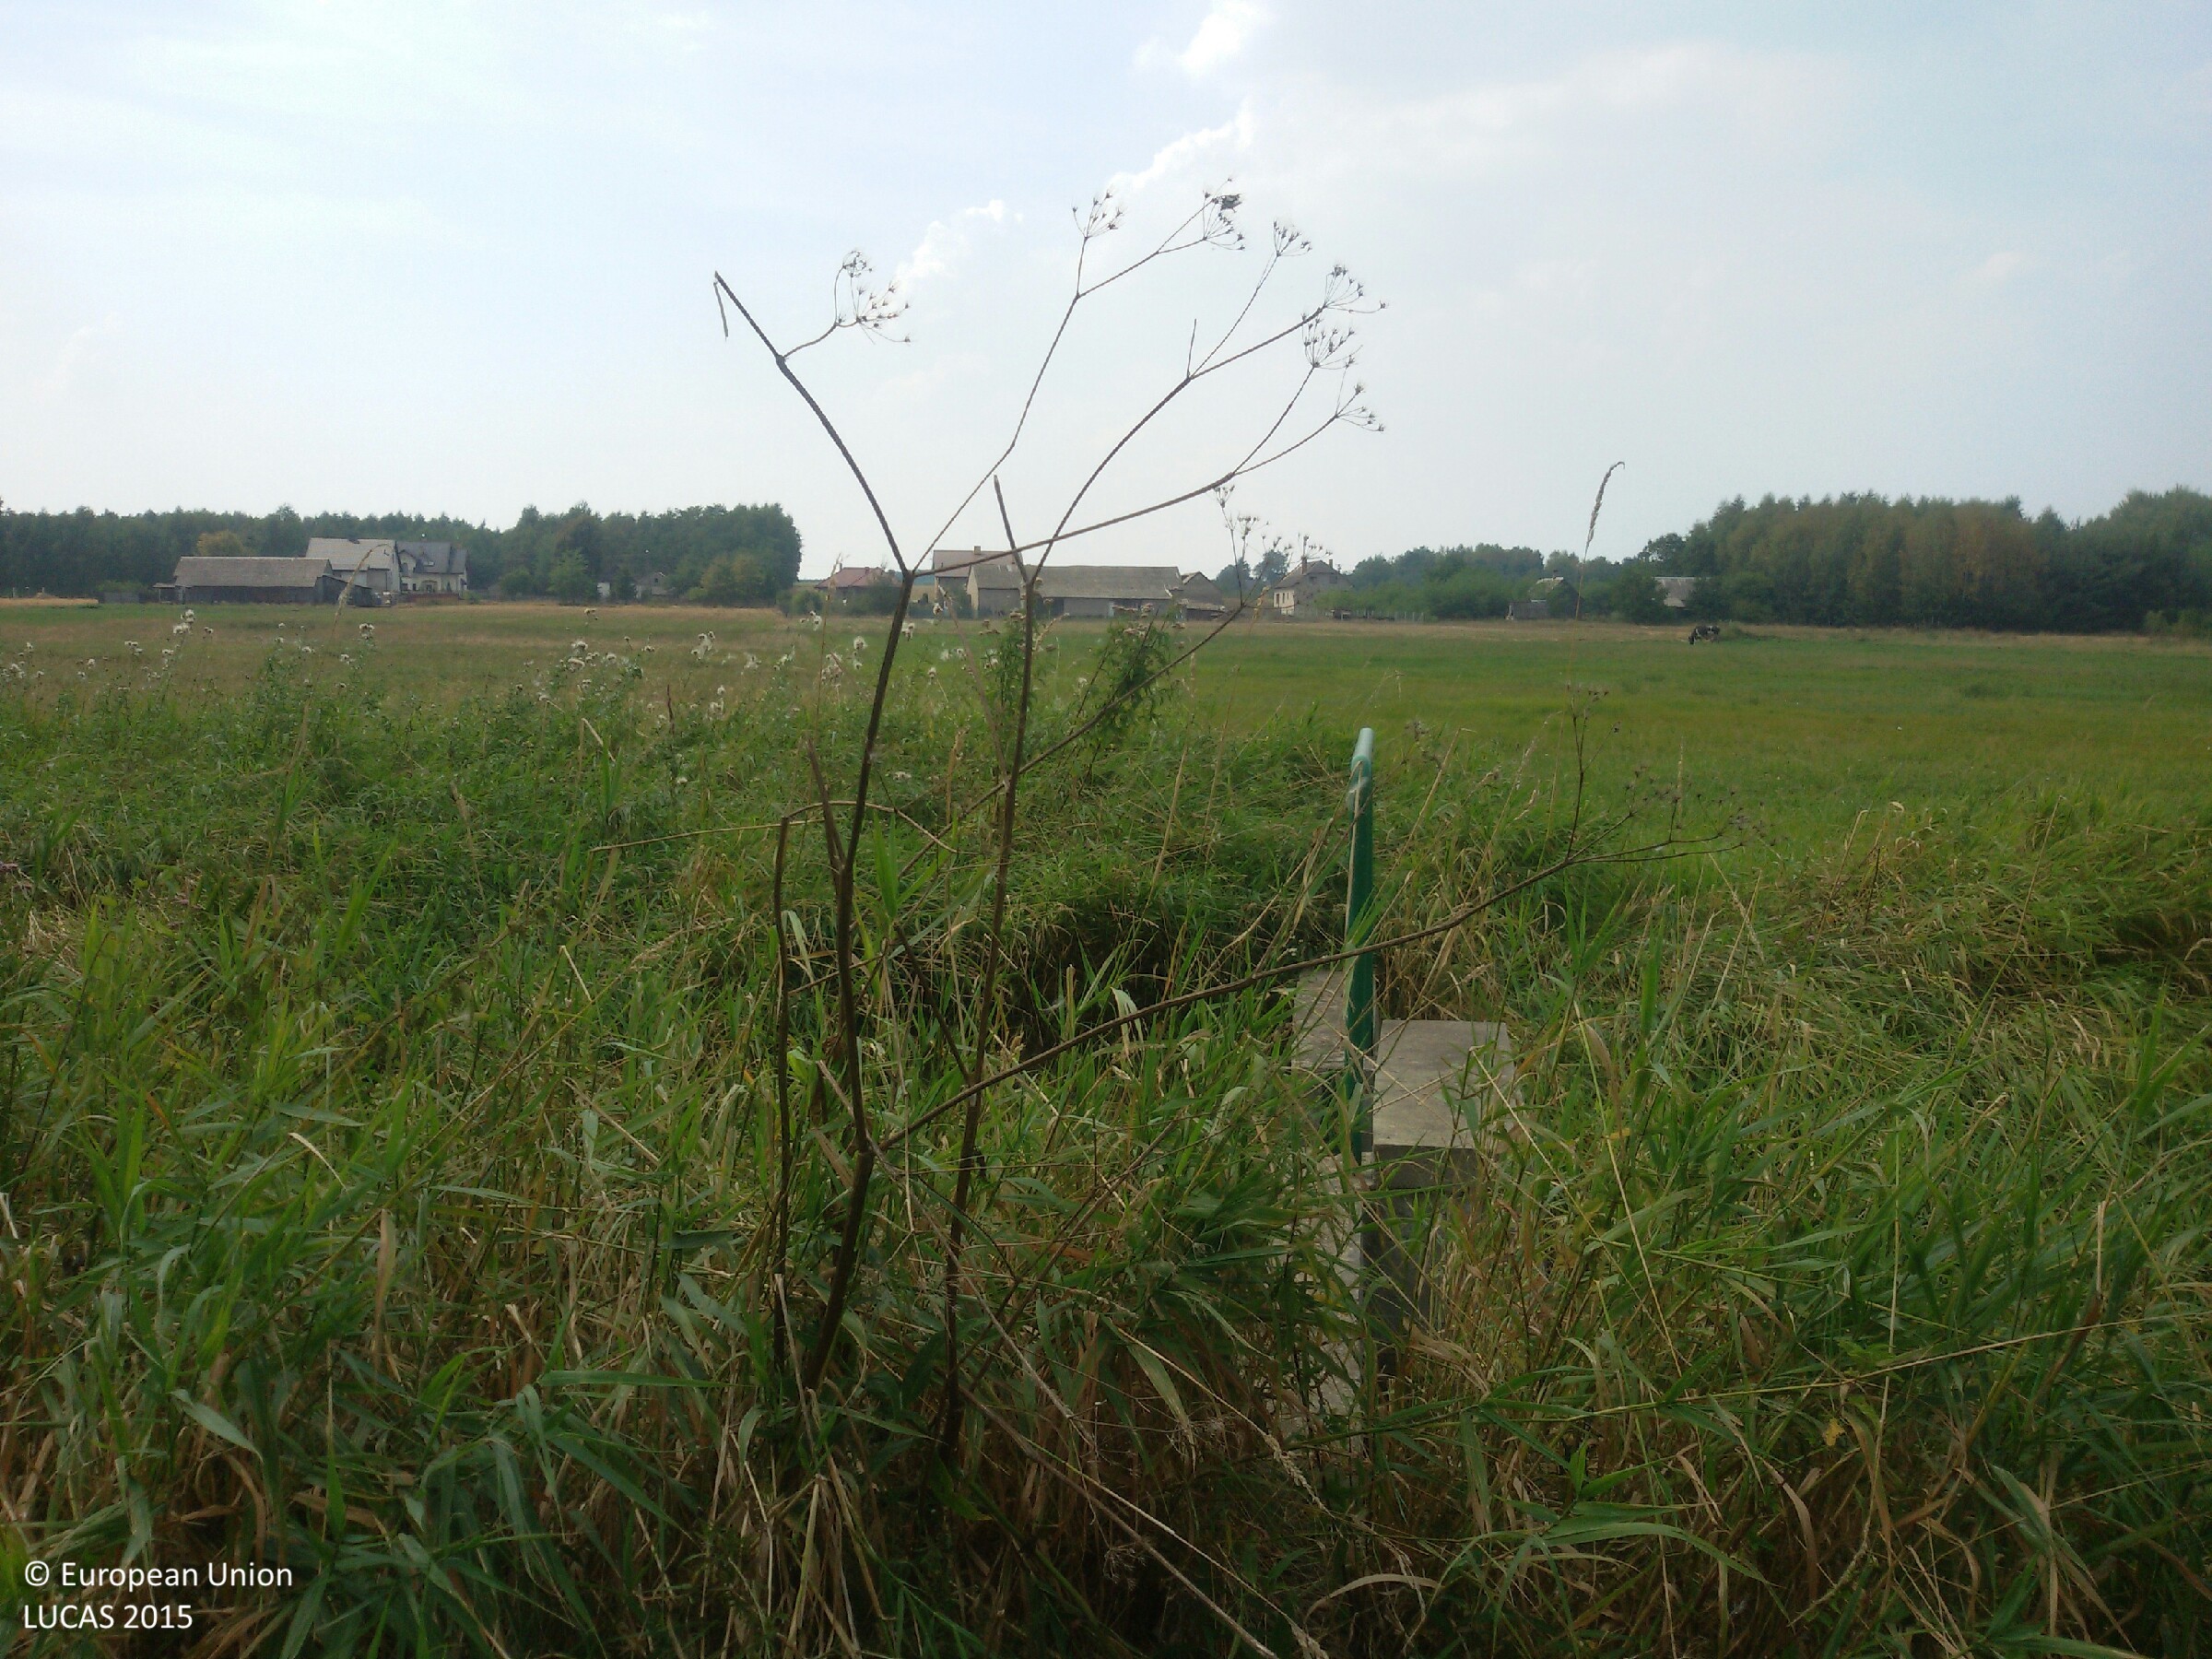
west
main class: Woodland
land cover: Broadleaved woodland
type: mesophytic deciduous forest
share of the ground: > 75 %
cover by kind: broadleaved forest trees 100 %
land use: Semi-natural and natural areas not in use
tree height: > 5 m
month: August
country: PL
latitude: 51.3971
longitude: 20.9530
